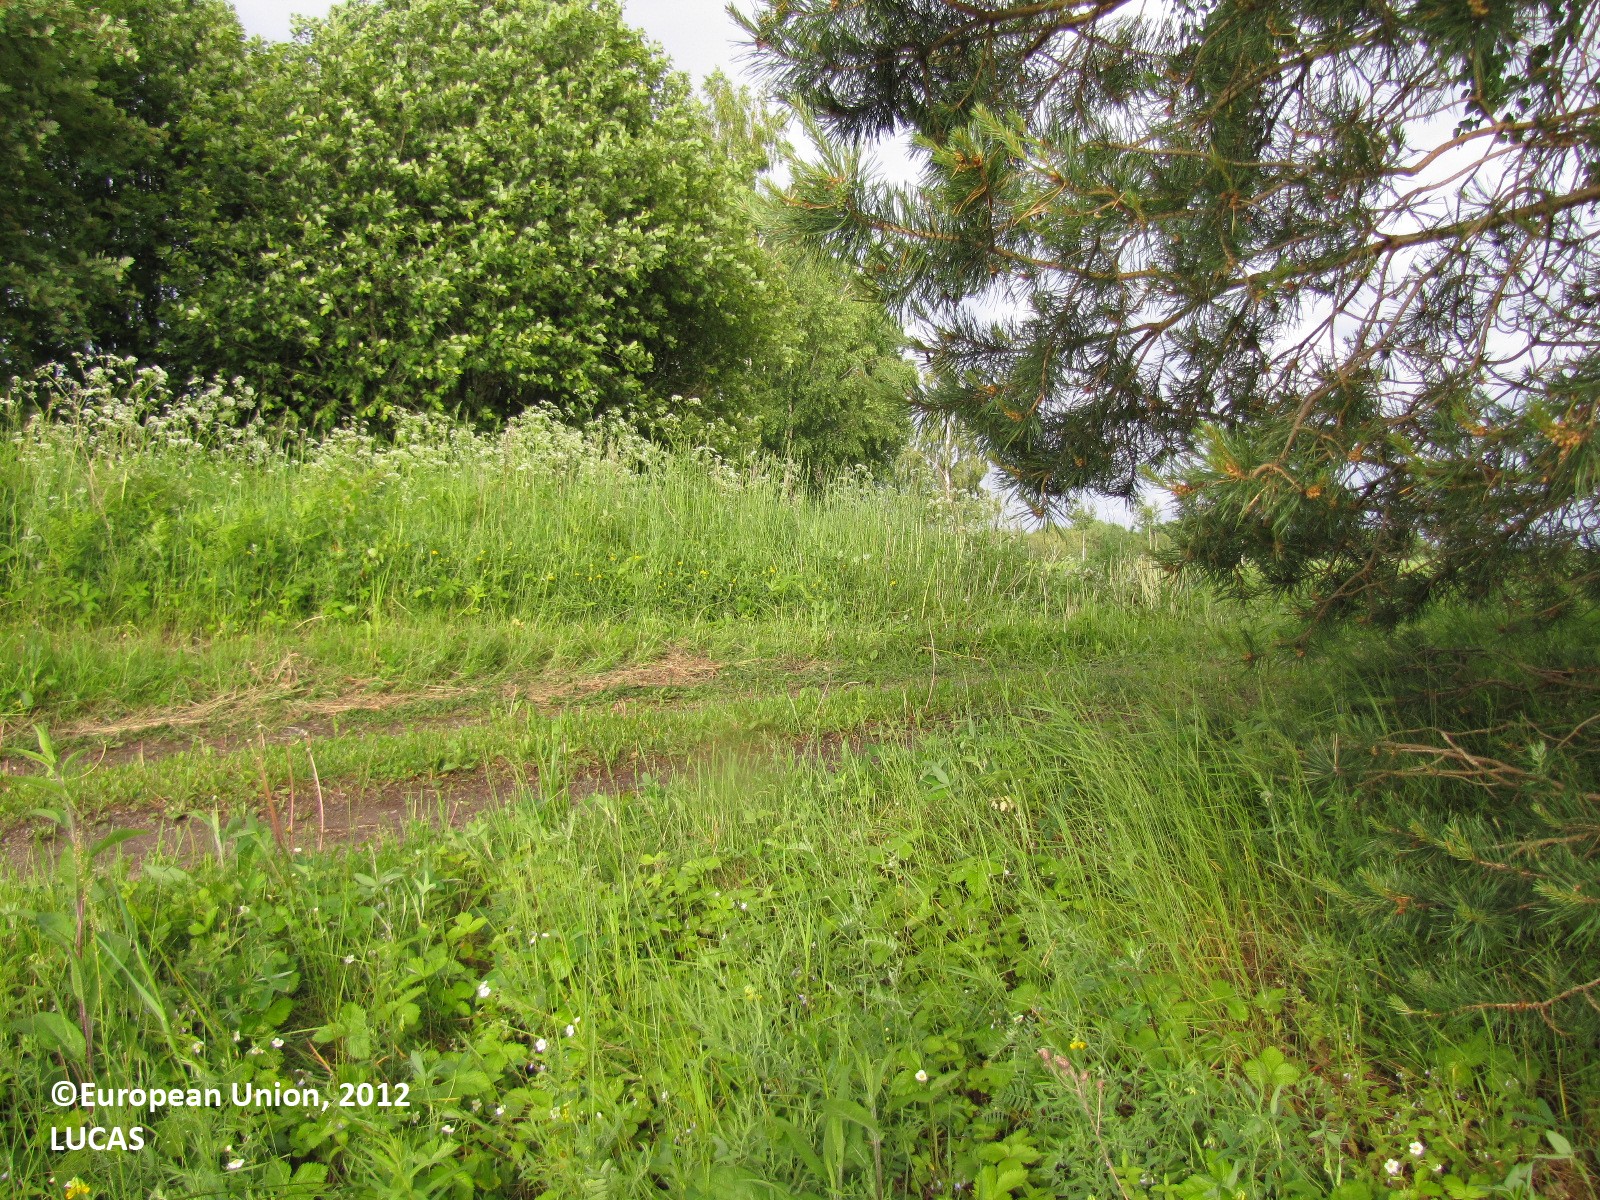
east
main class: Cropland
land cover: Barley
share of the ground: 50 - 75 %
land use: Agriculture (excluding fallow land and kitchen gardens)
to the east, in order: Barley; Grass margins; Tracks; Grass margins; Temporary grasslands; Broadleaved woodland; Temporary grasslands; Ditches and canals; Temporary grasslands; Tracks; Lines of trees; Grass margins; Ditches and canals; Grass margins; Common wheat
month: June
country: FI
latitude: 61.2356
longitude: 24.5770
